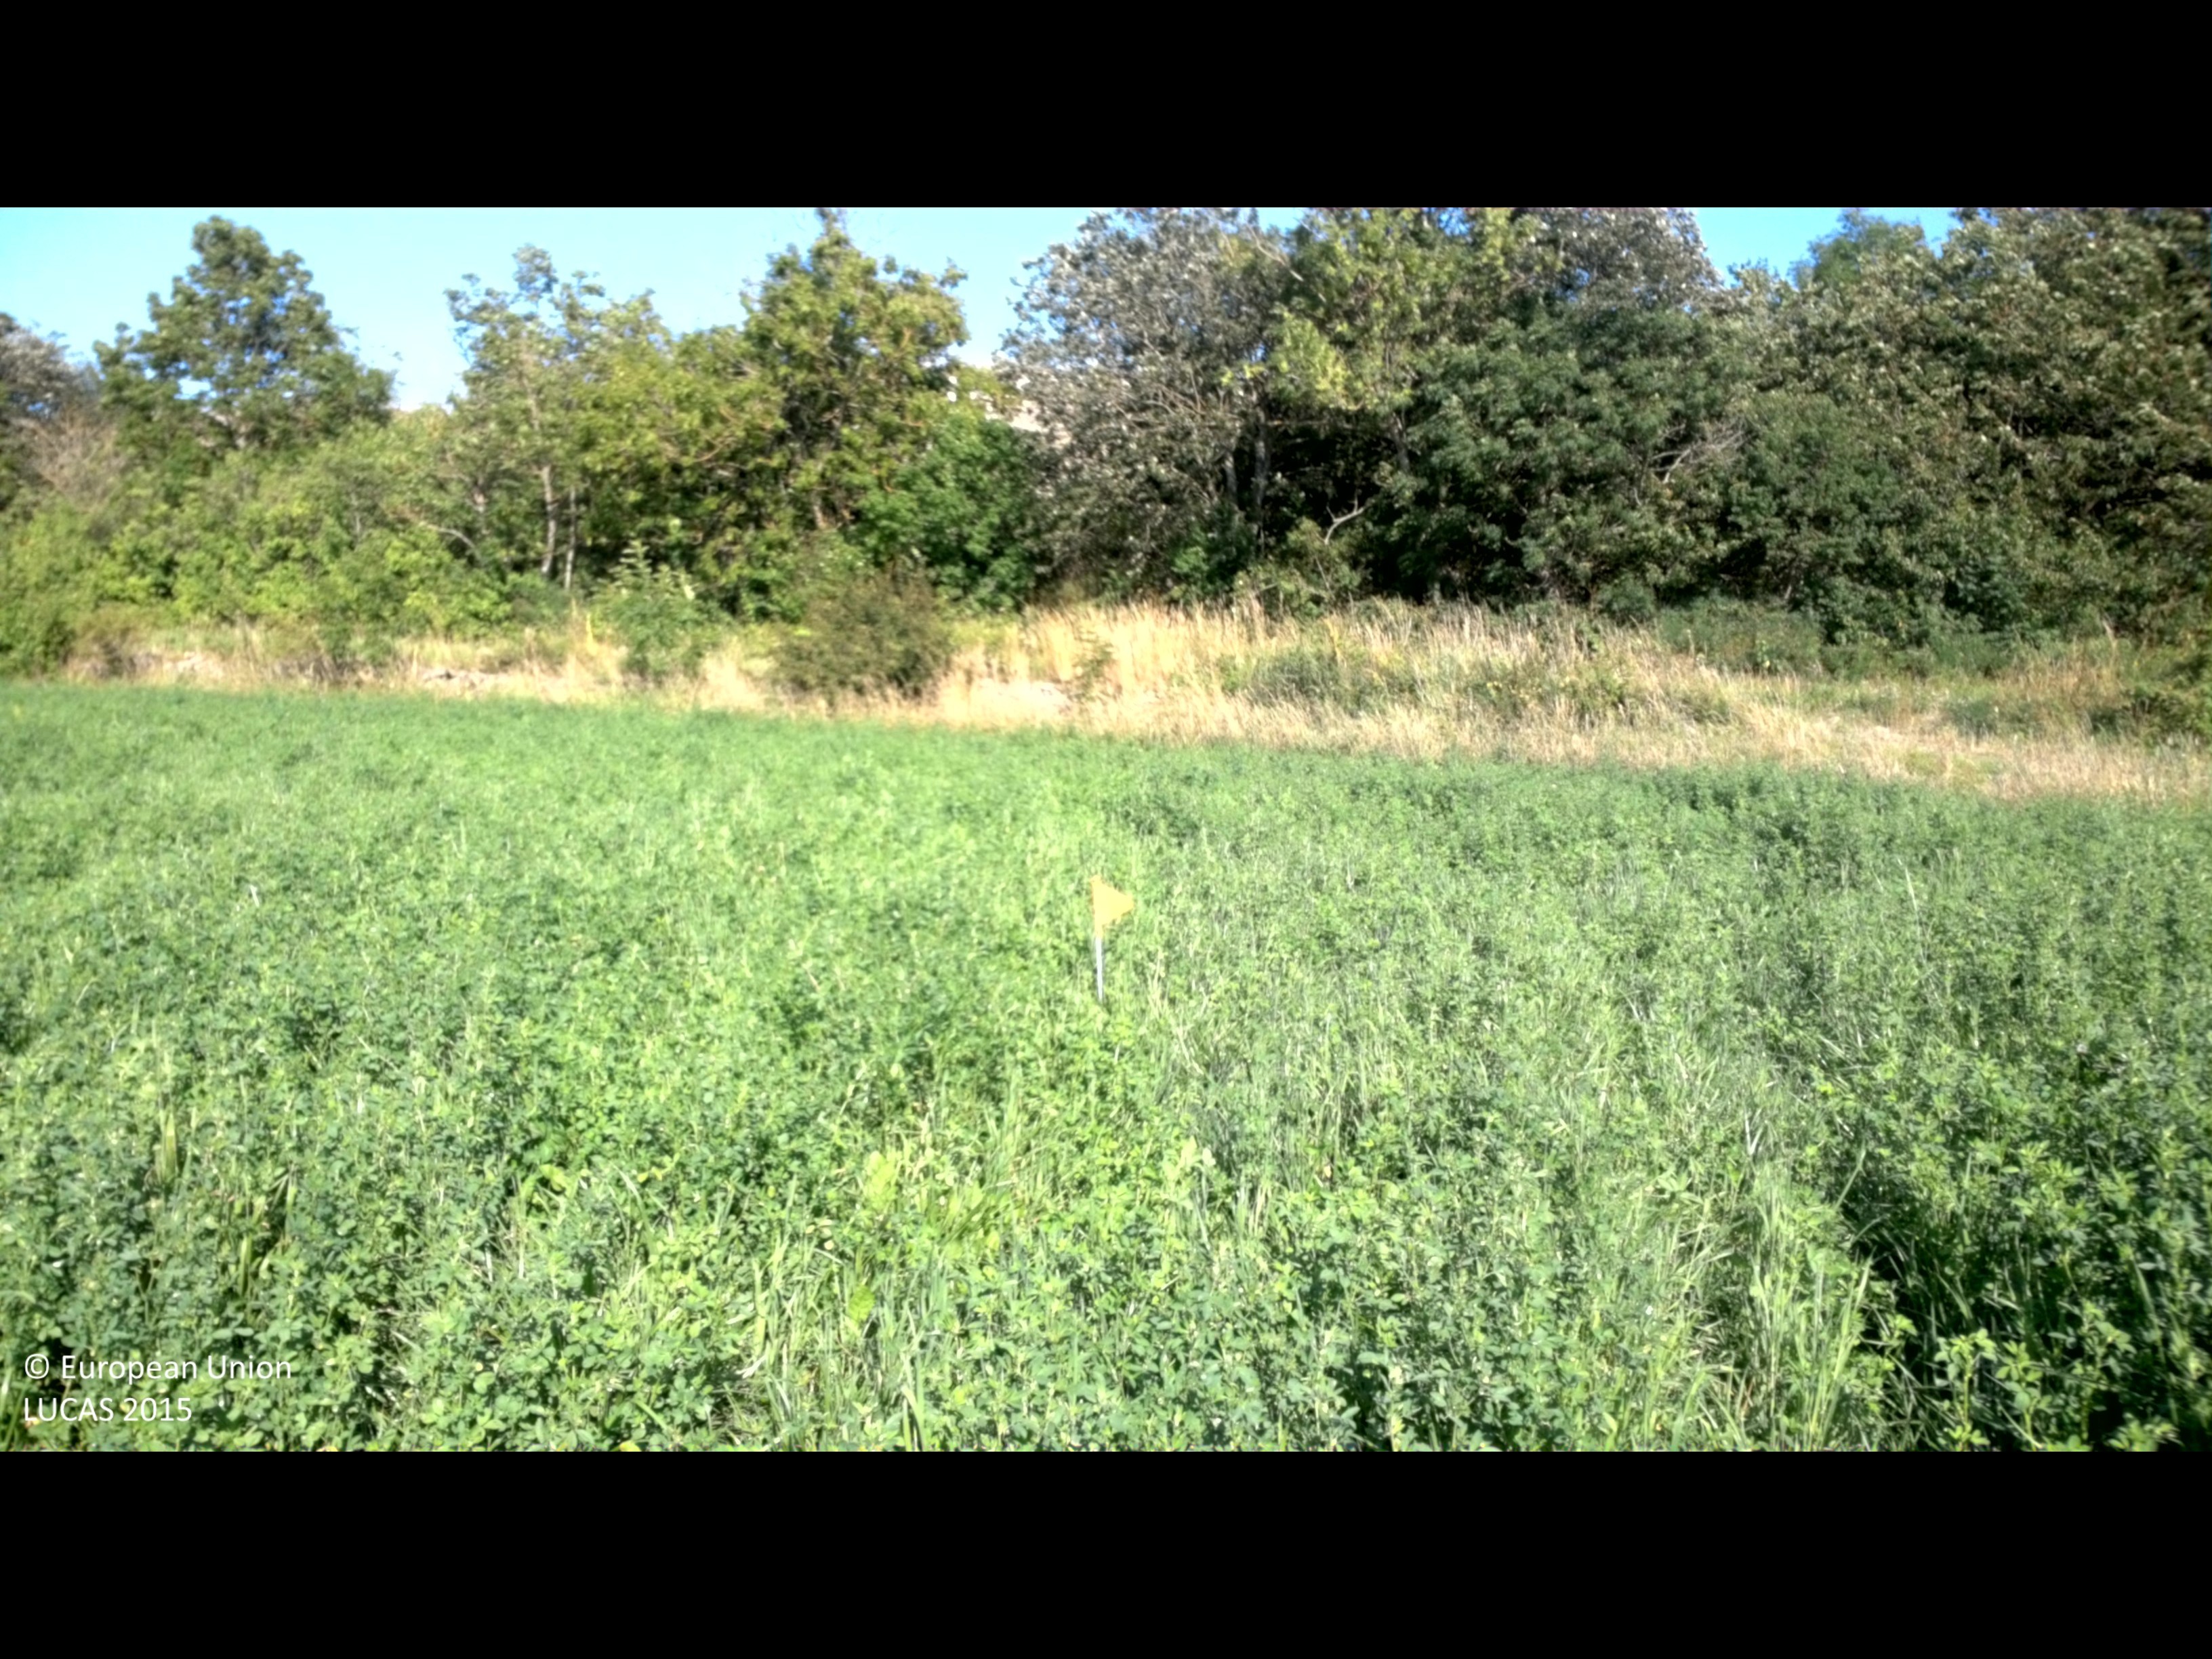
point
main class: Cropland
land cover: Lucerne
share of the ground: > 75 %
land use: Agriculture (excluding fallow land and kitchen gardens)
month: July
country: SE
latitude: 56.3873
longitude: 16.4321
